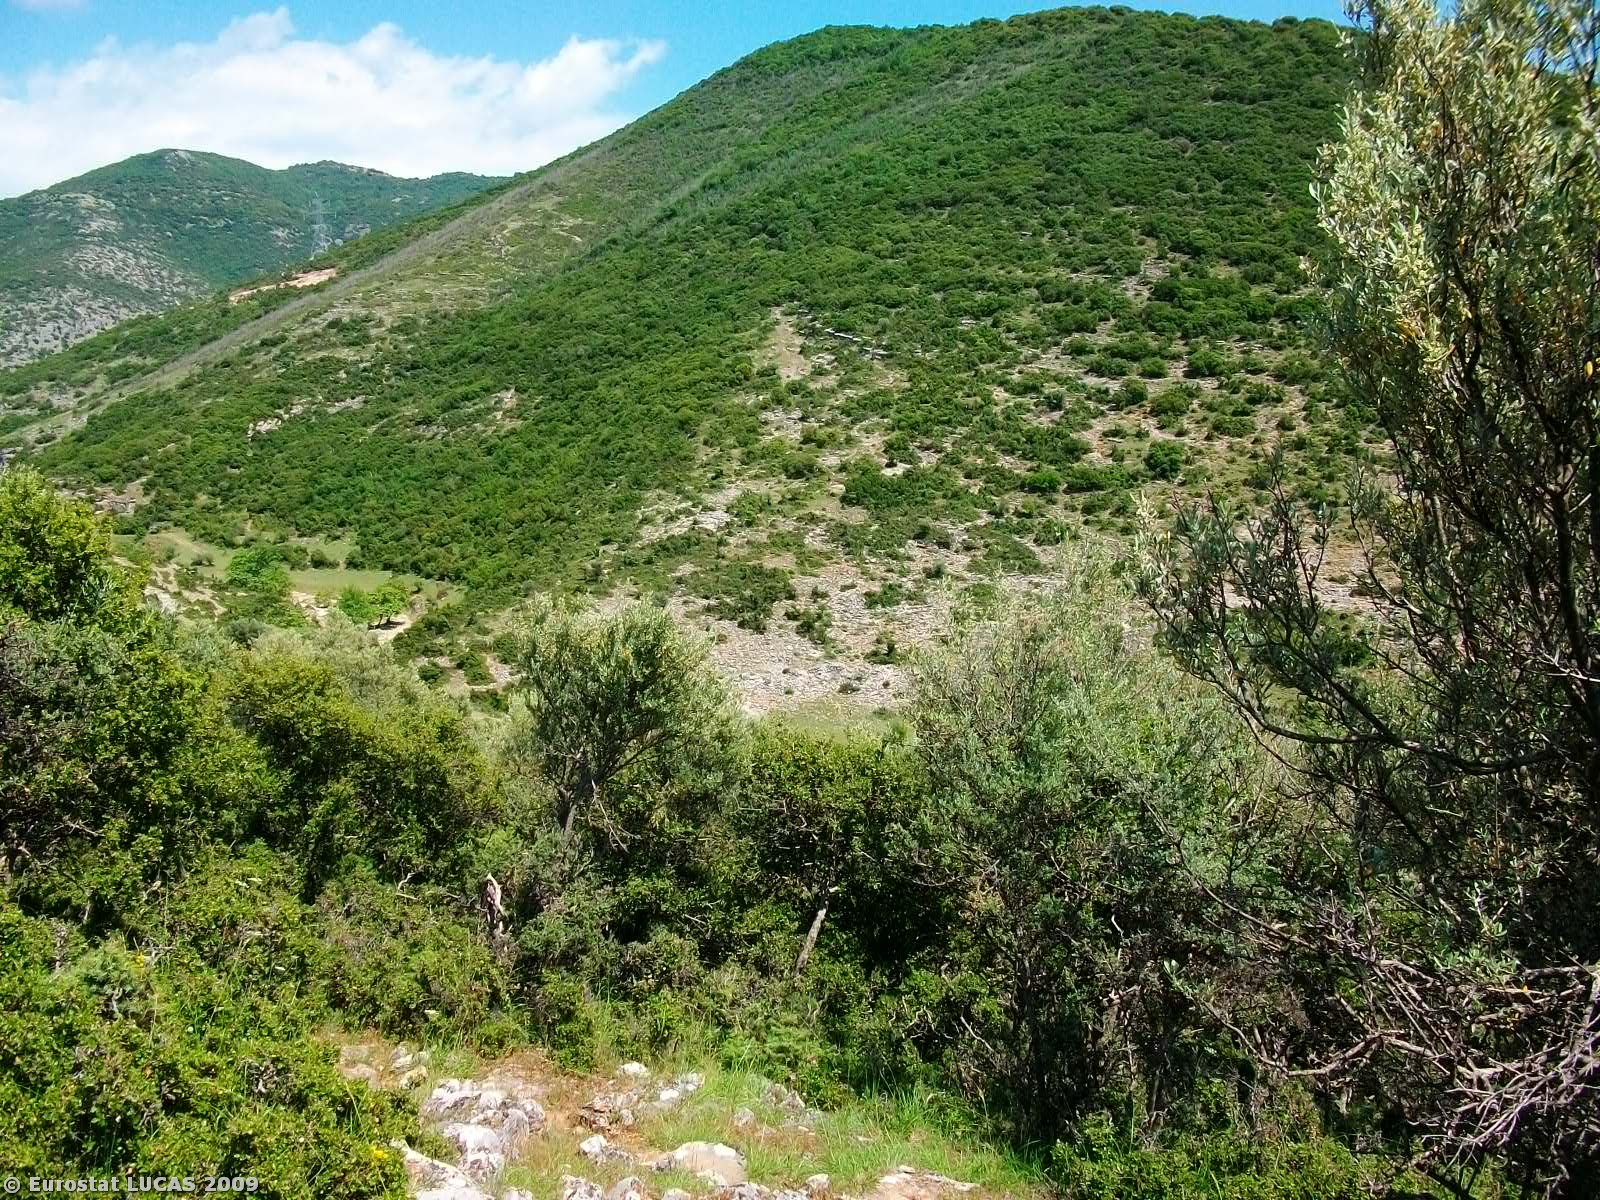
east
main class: Shrubland
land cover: Shrubland with sparse tree cover
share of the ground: 50 - 75 %
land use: Agriculture (excluding fallow land and kitchen gardens)
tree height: < 5 m
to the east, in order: Shrubland with sparse tree cover; Grassland without tree/shrub cover; Shrubland without tree cover; Tracks; Dry stone walls; Rock outcrops; Lines of trees; Paved roads, cycling and walking lanes; Grassland with sparse tree/shrub cover; Dry stone walls; Shrubland with sparse tree cover
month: May
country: GR
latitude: 41.0343
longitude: 24.3886
